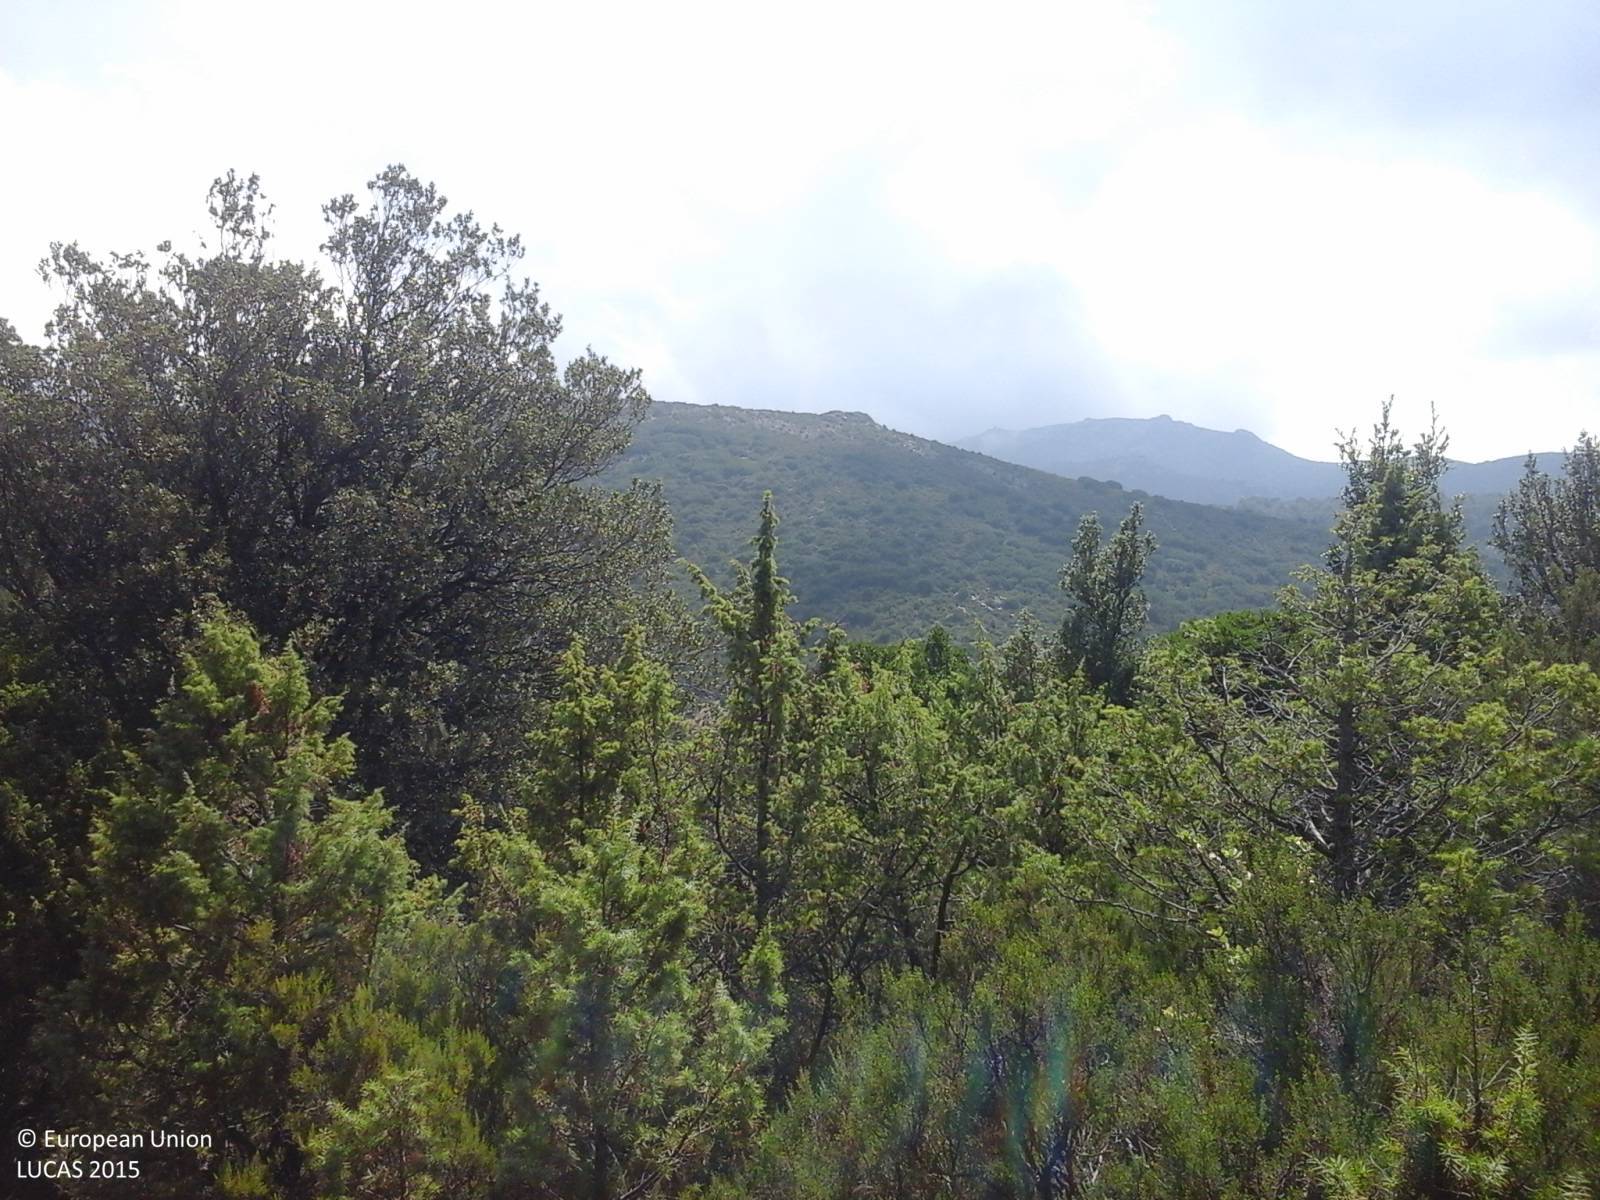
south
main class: Shrubland
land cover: Shrubland without tree cover
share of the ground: > 75 %
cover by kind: shrubs 90 %, herbaceous plants 10 %
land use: Semi-natural and natural areas not in use
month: September
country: IT
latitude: 40.0304
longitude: 9.4522
